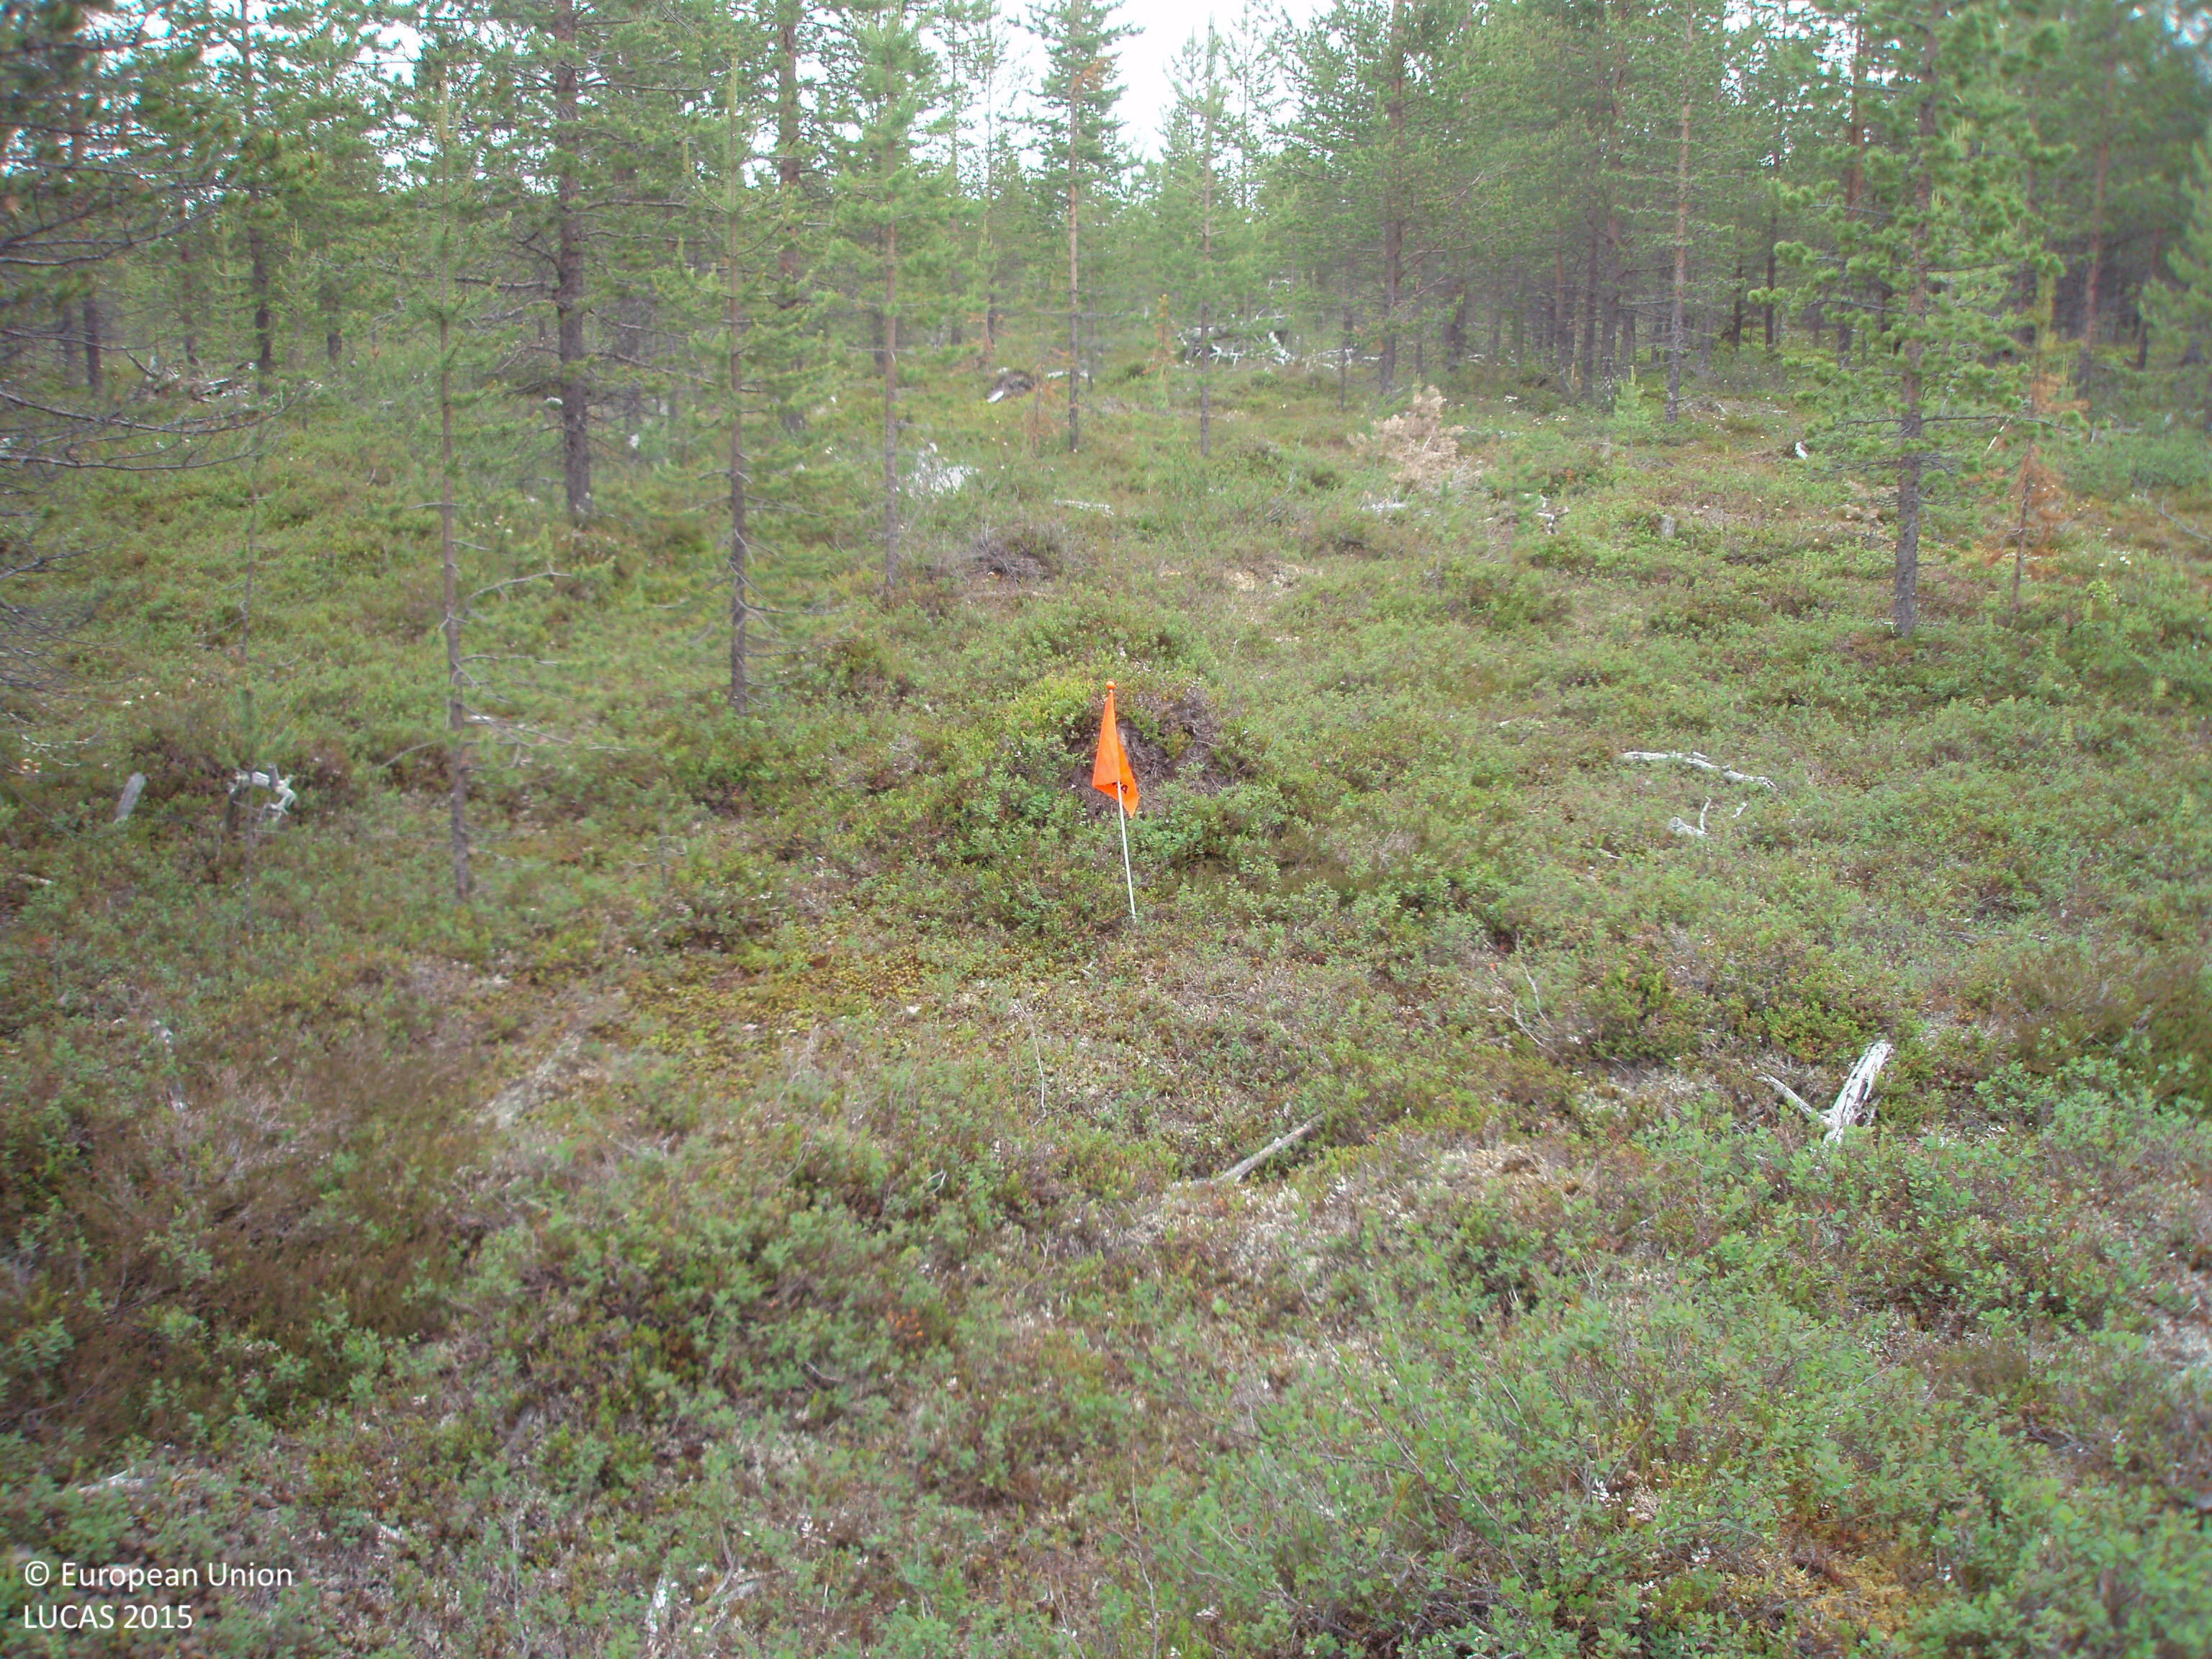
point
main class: Woodland
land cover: Pine dominated coniferous woodland
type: boreal forest
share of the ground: 25 - 50 %
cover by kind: shrubs 60 %, coniferous forest trees 35 %, lichens and mosses 5 %
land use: Forestry
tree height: < 5 m
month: July
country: FI
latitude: 67.7649
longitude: 29.0639
